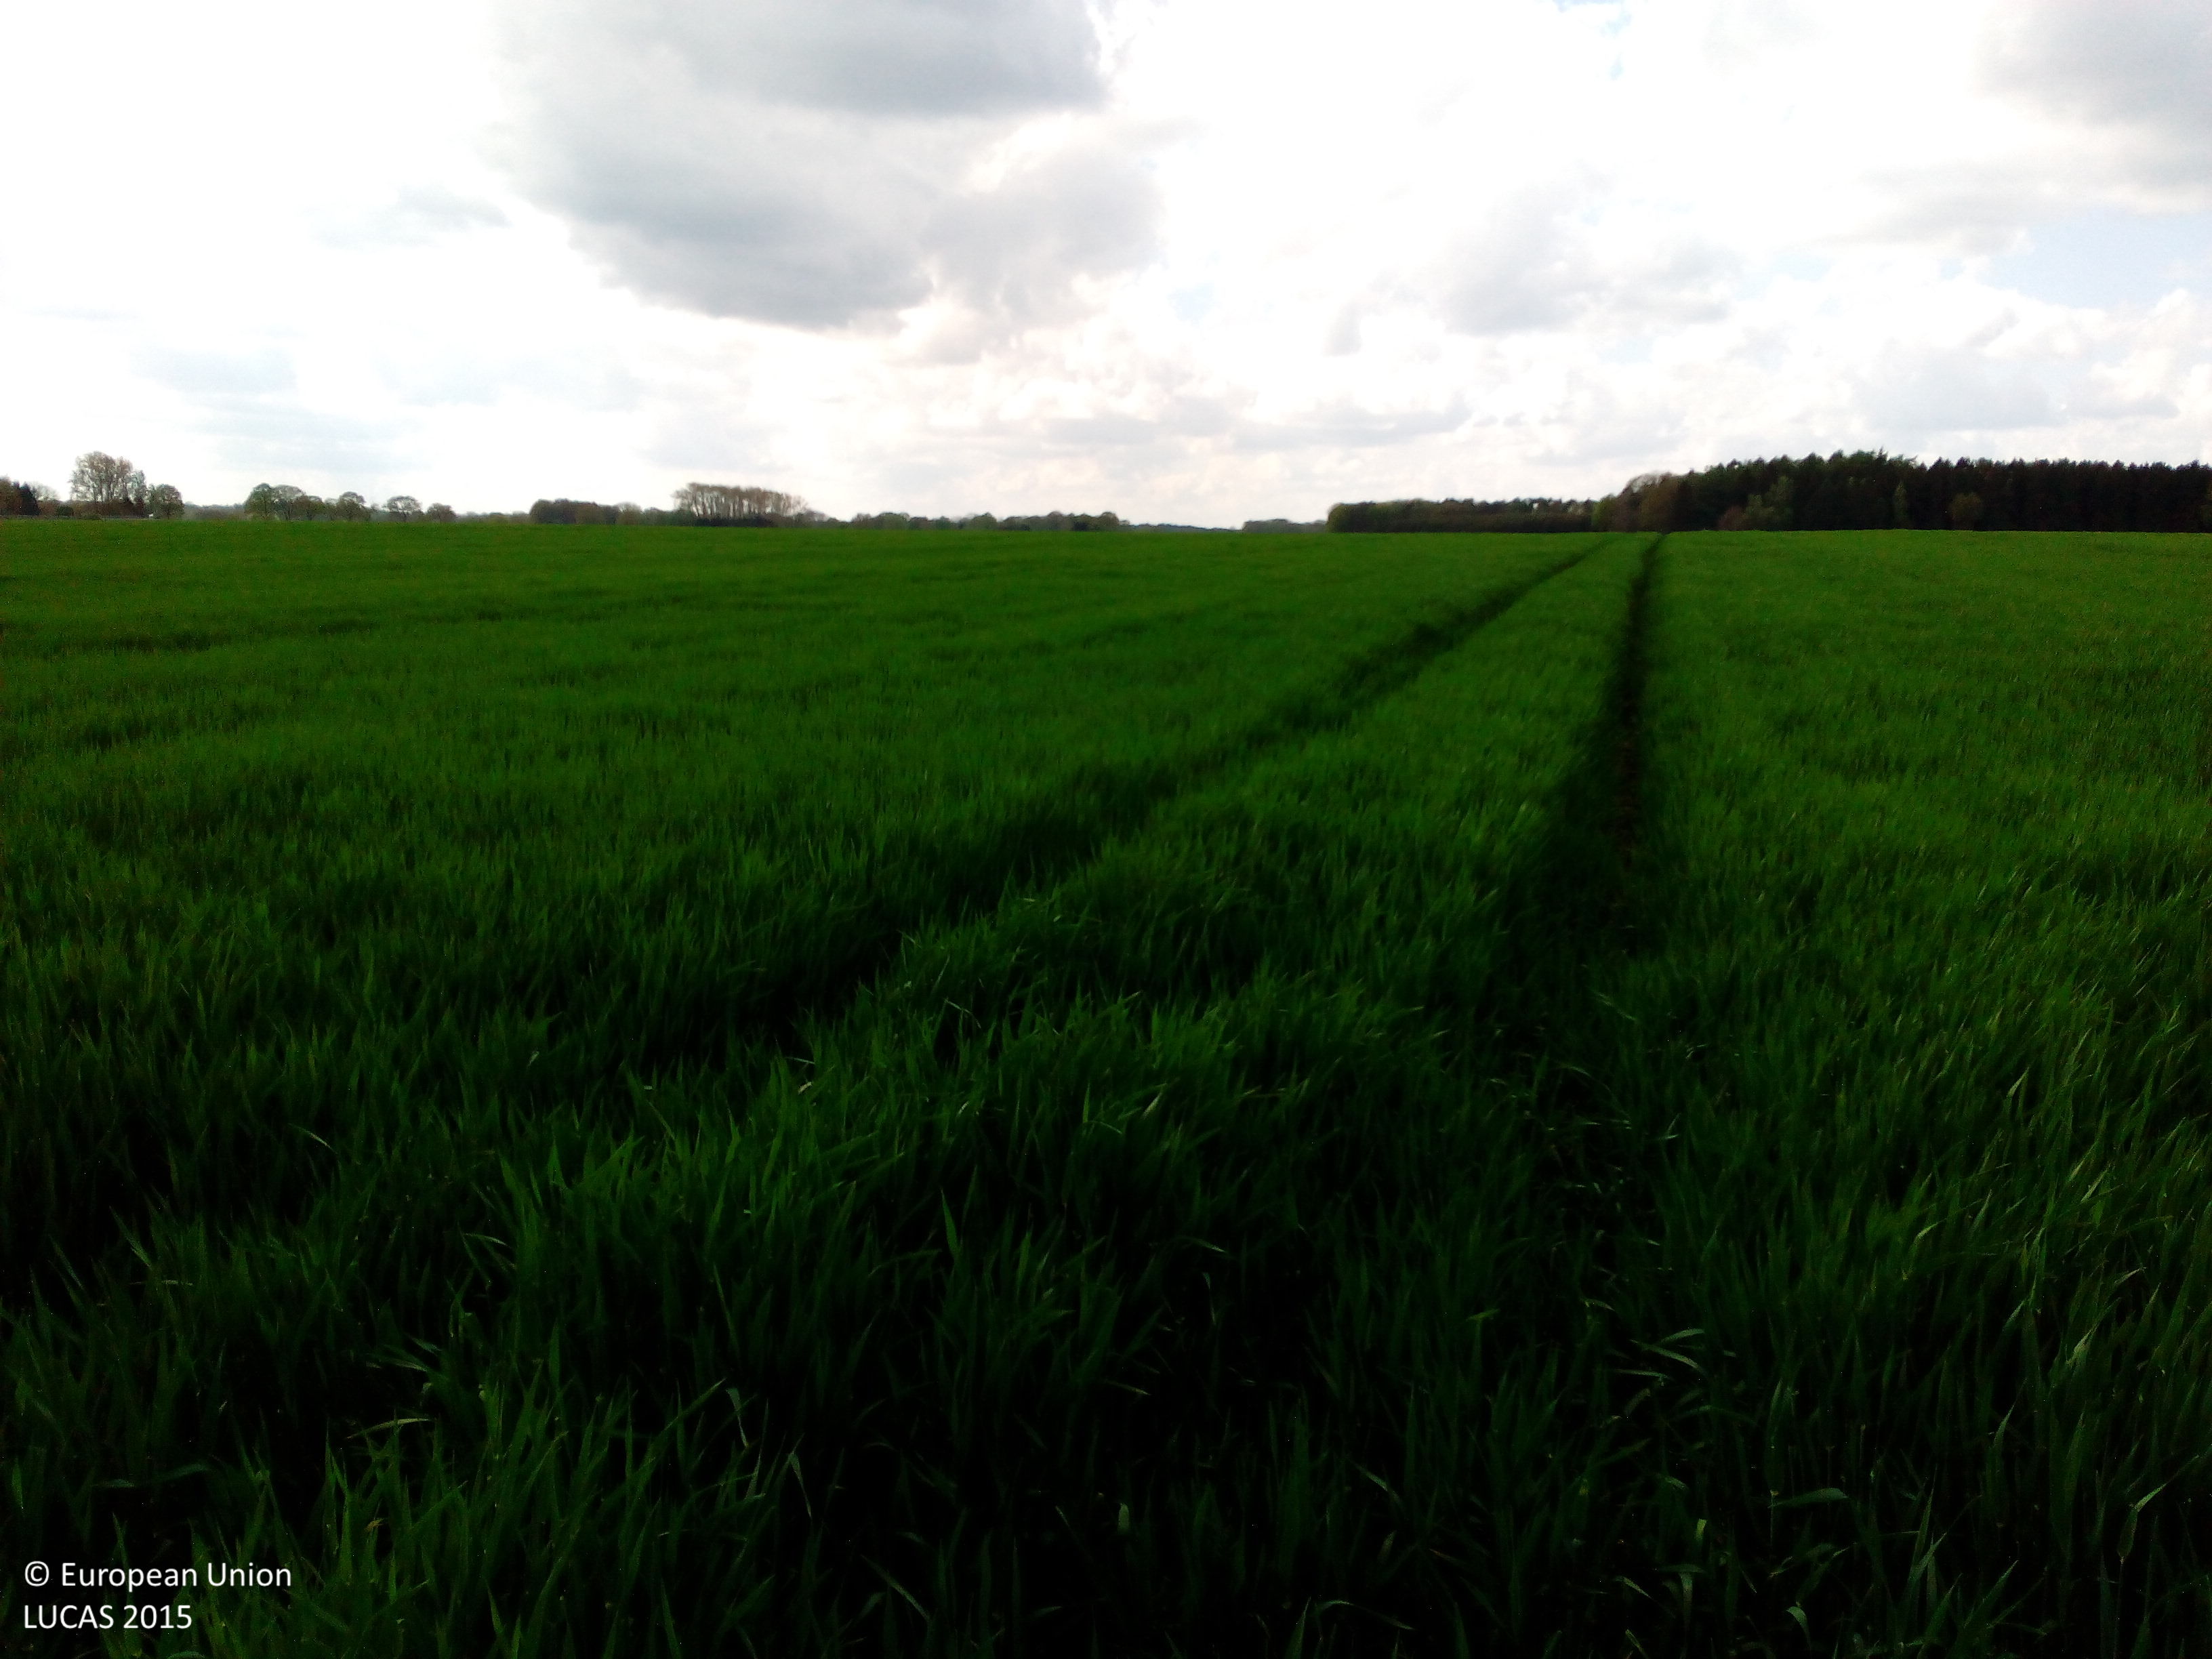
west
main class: Cropland
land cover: Barley
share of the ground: > 75 %
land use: Agriculture (excluding fallow land and kitchen gardens)
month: May
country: DE
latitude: 52.8640
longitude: 7.9953
